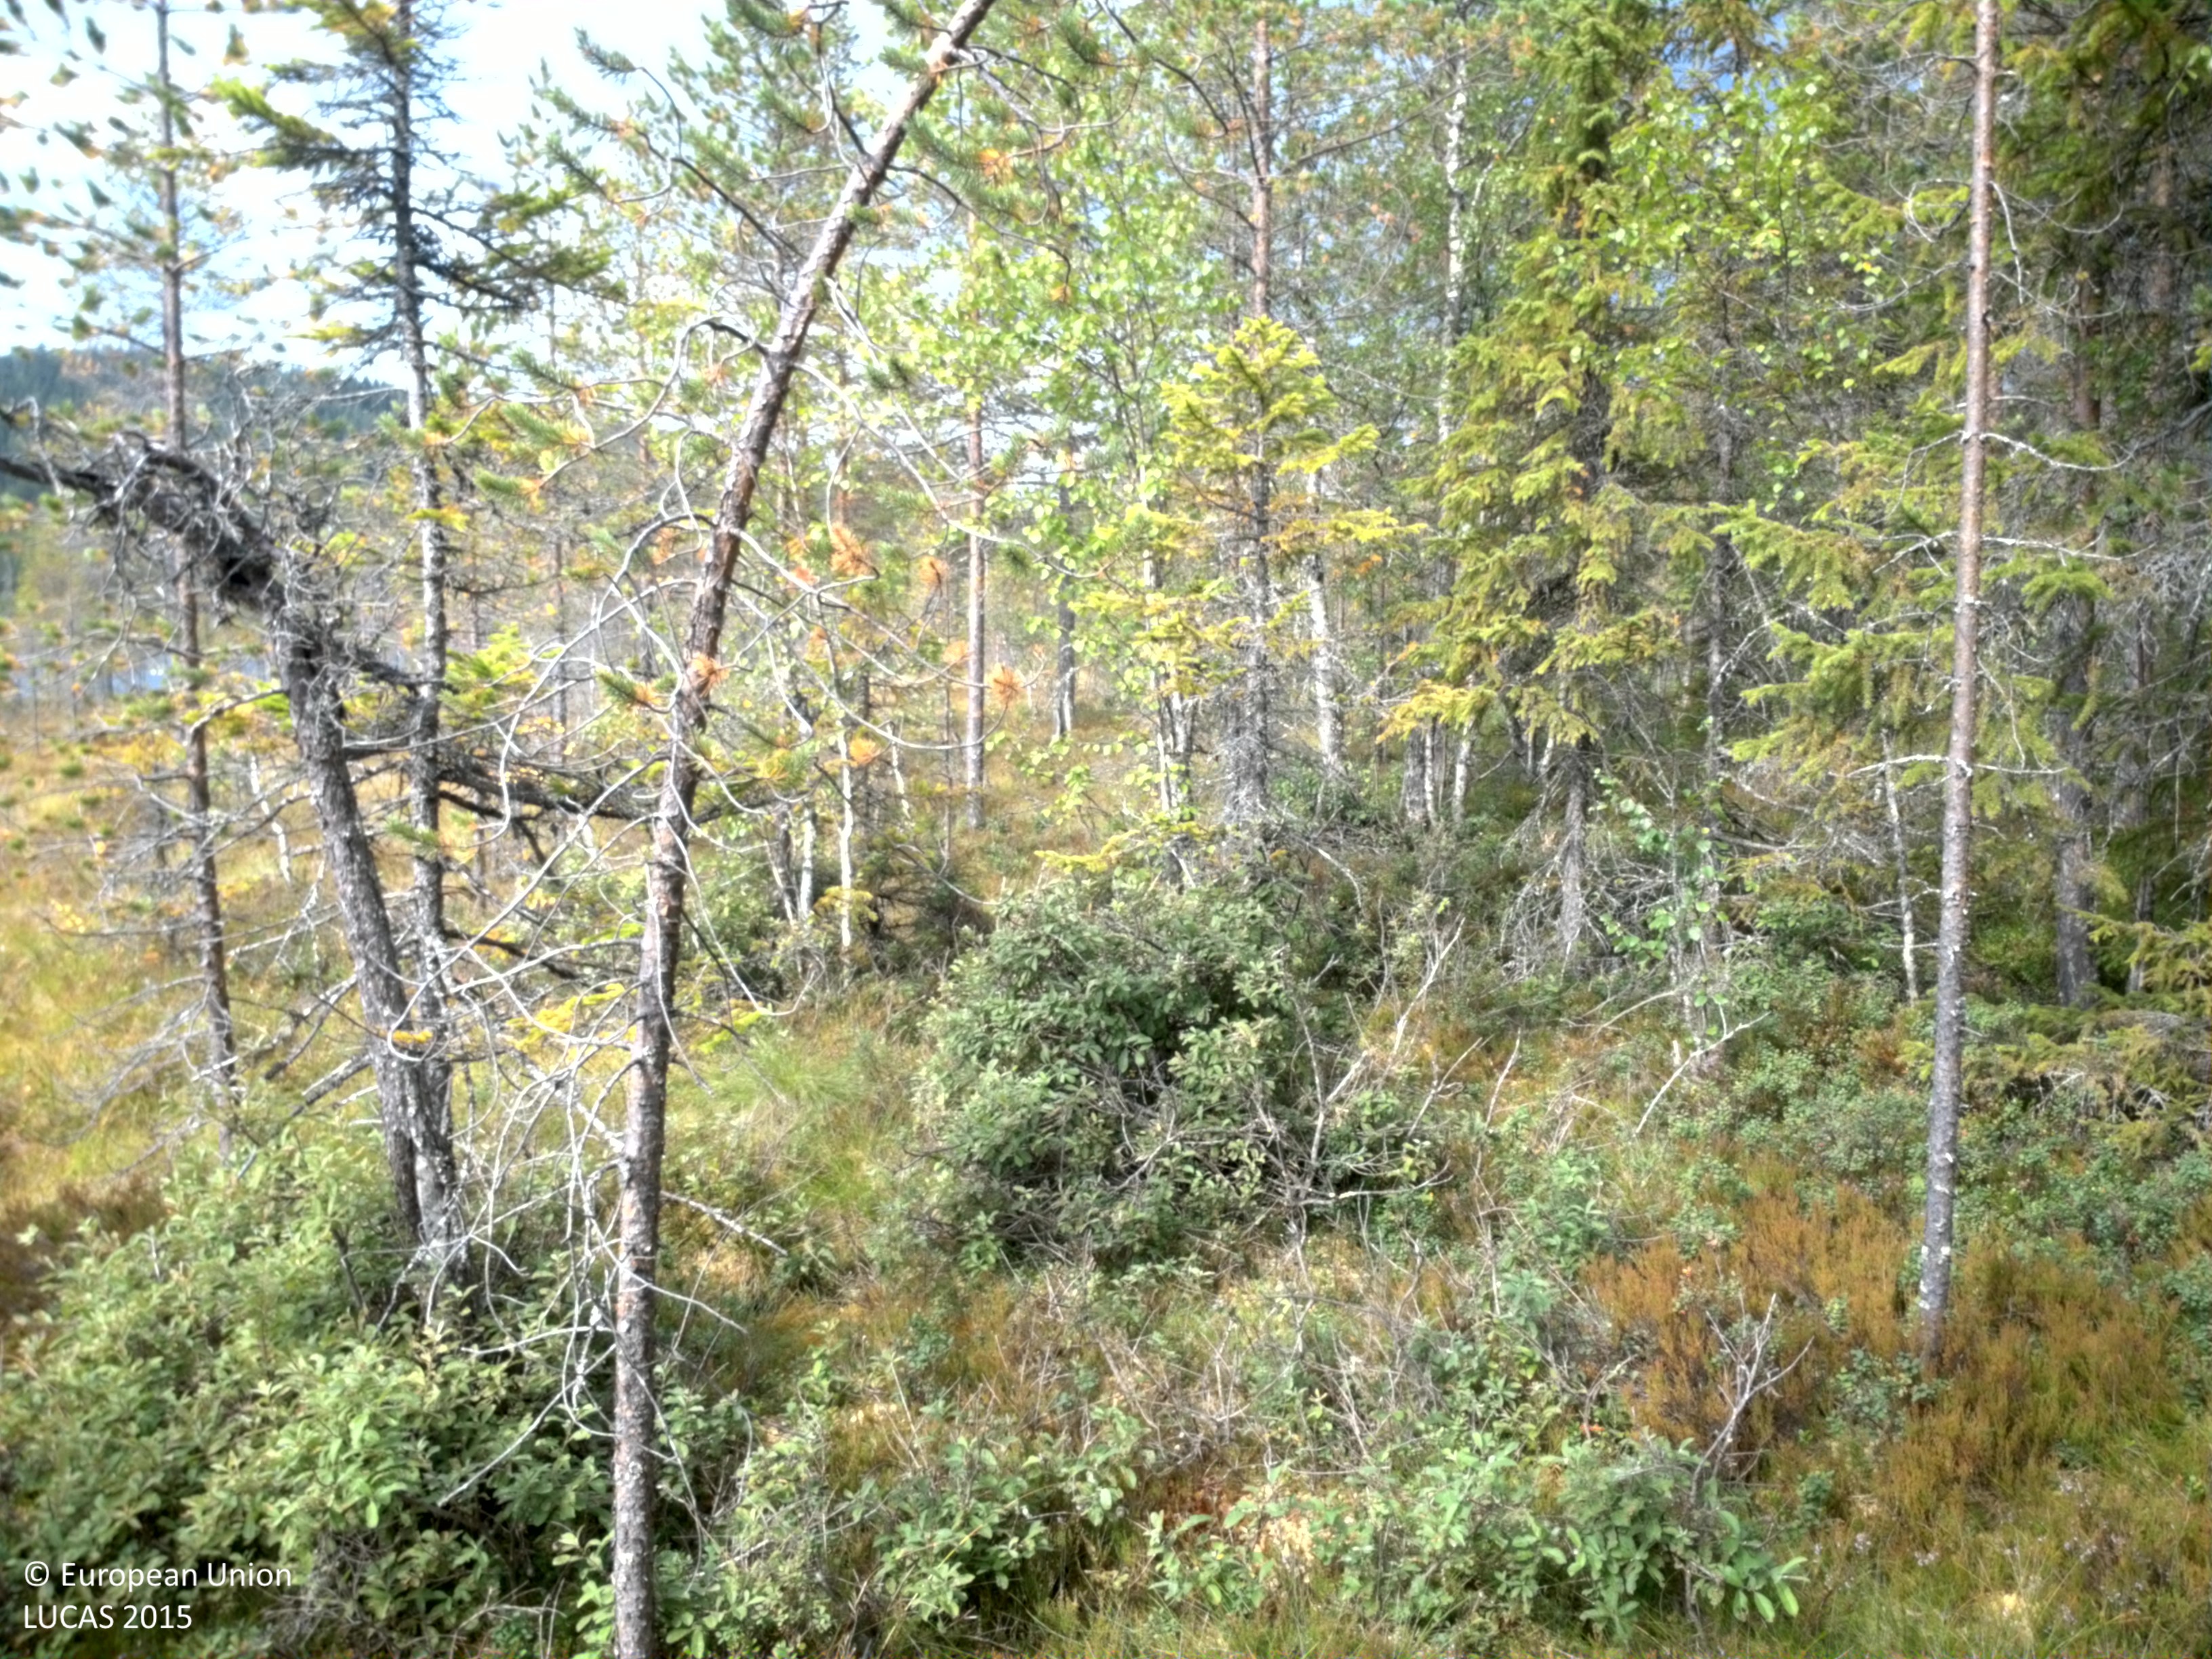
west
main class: Woodland
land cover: Pine dominated mixed woodland
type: boreal forest
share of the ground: 25 - 50 %
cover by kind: coniferous forest trees 35 %, lichens and mosses 25 %, shrubs 20 %, broadleaved forest trees 15 %, herbaceous plants 5 %
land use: Forestry
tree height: > 5 m
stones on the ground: < 10 %
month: August
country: SE
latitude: 61.8628
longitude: 14.9443
